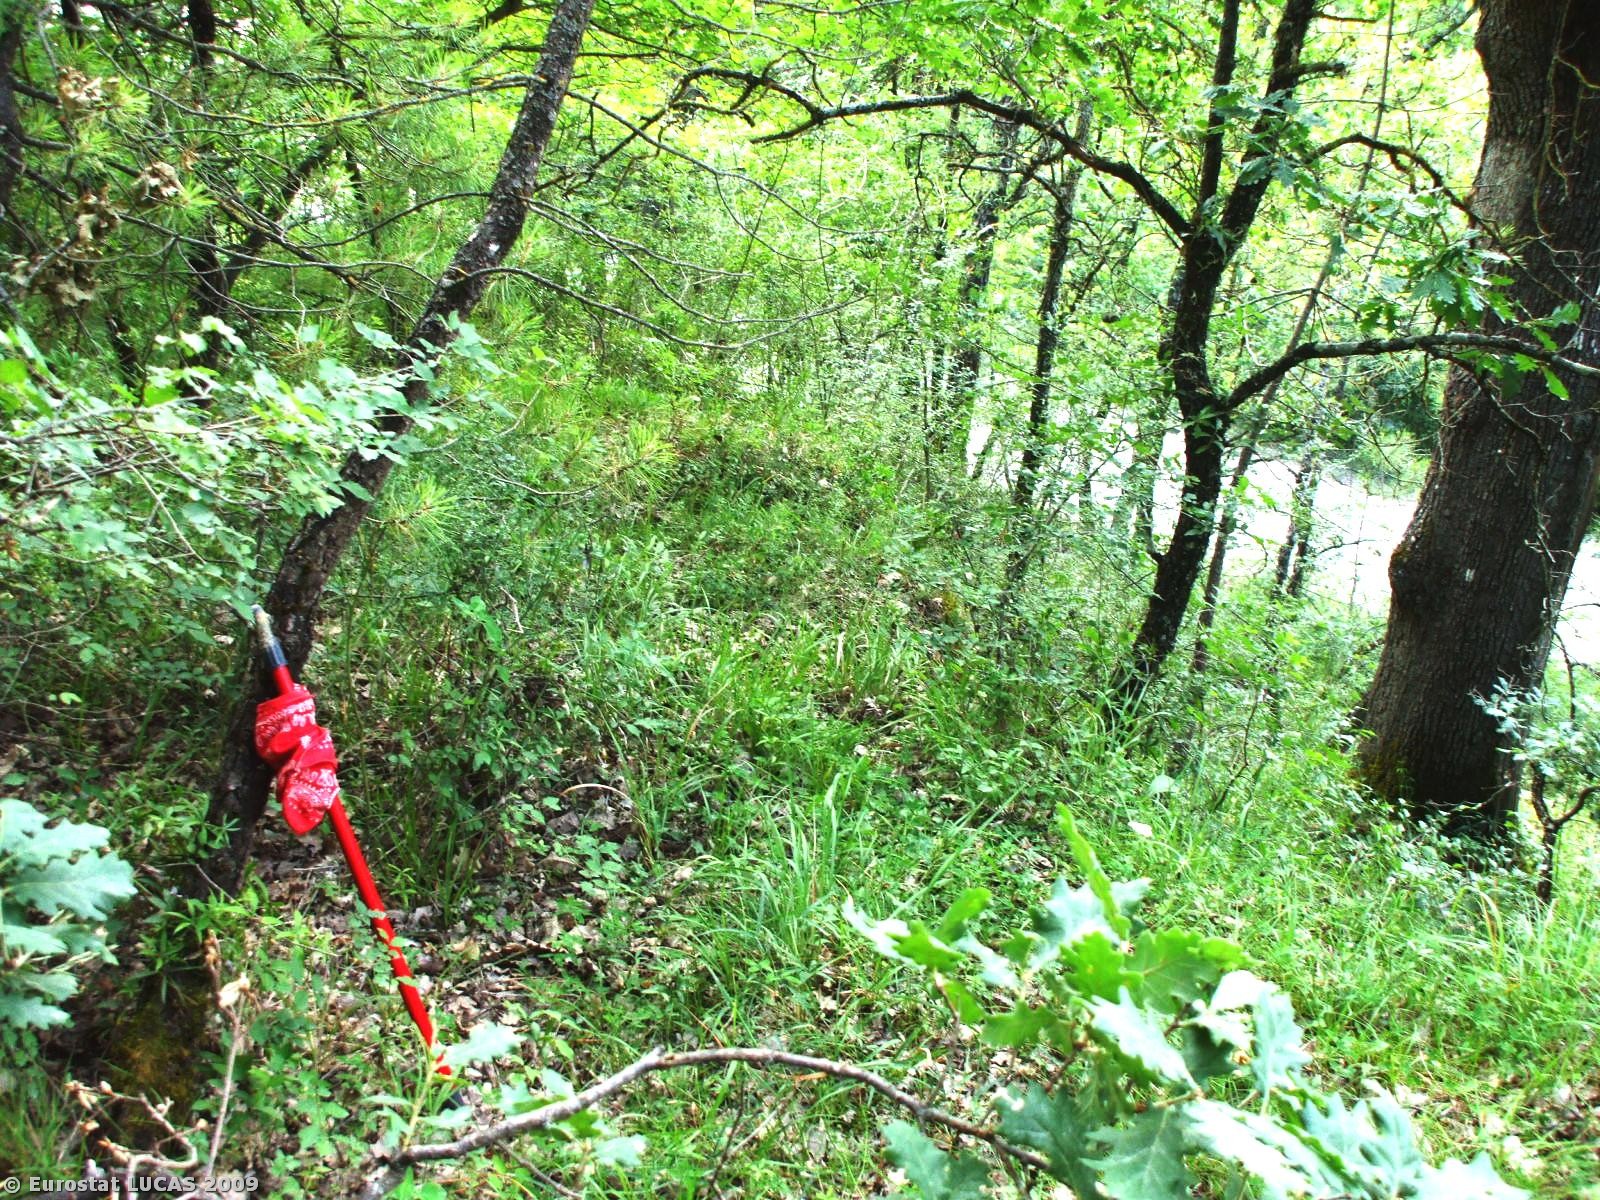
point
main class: Woodland
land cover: Mixed woodland
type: thermophilous deciduous forest
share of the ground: > 75 %
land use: Forestry
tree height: > 5 m
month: June
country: IT
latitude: 43.4843
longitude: 11.9359
